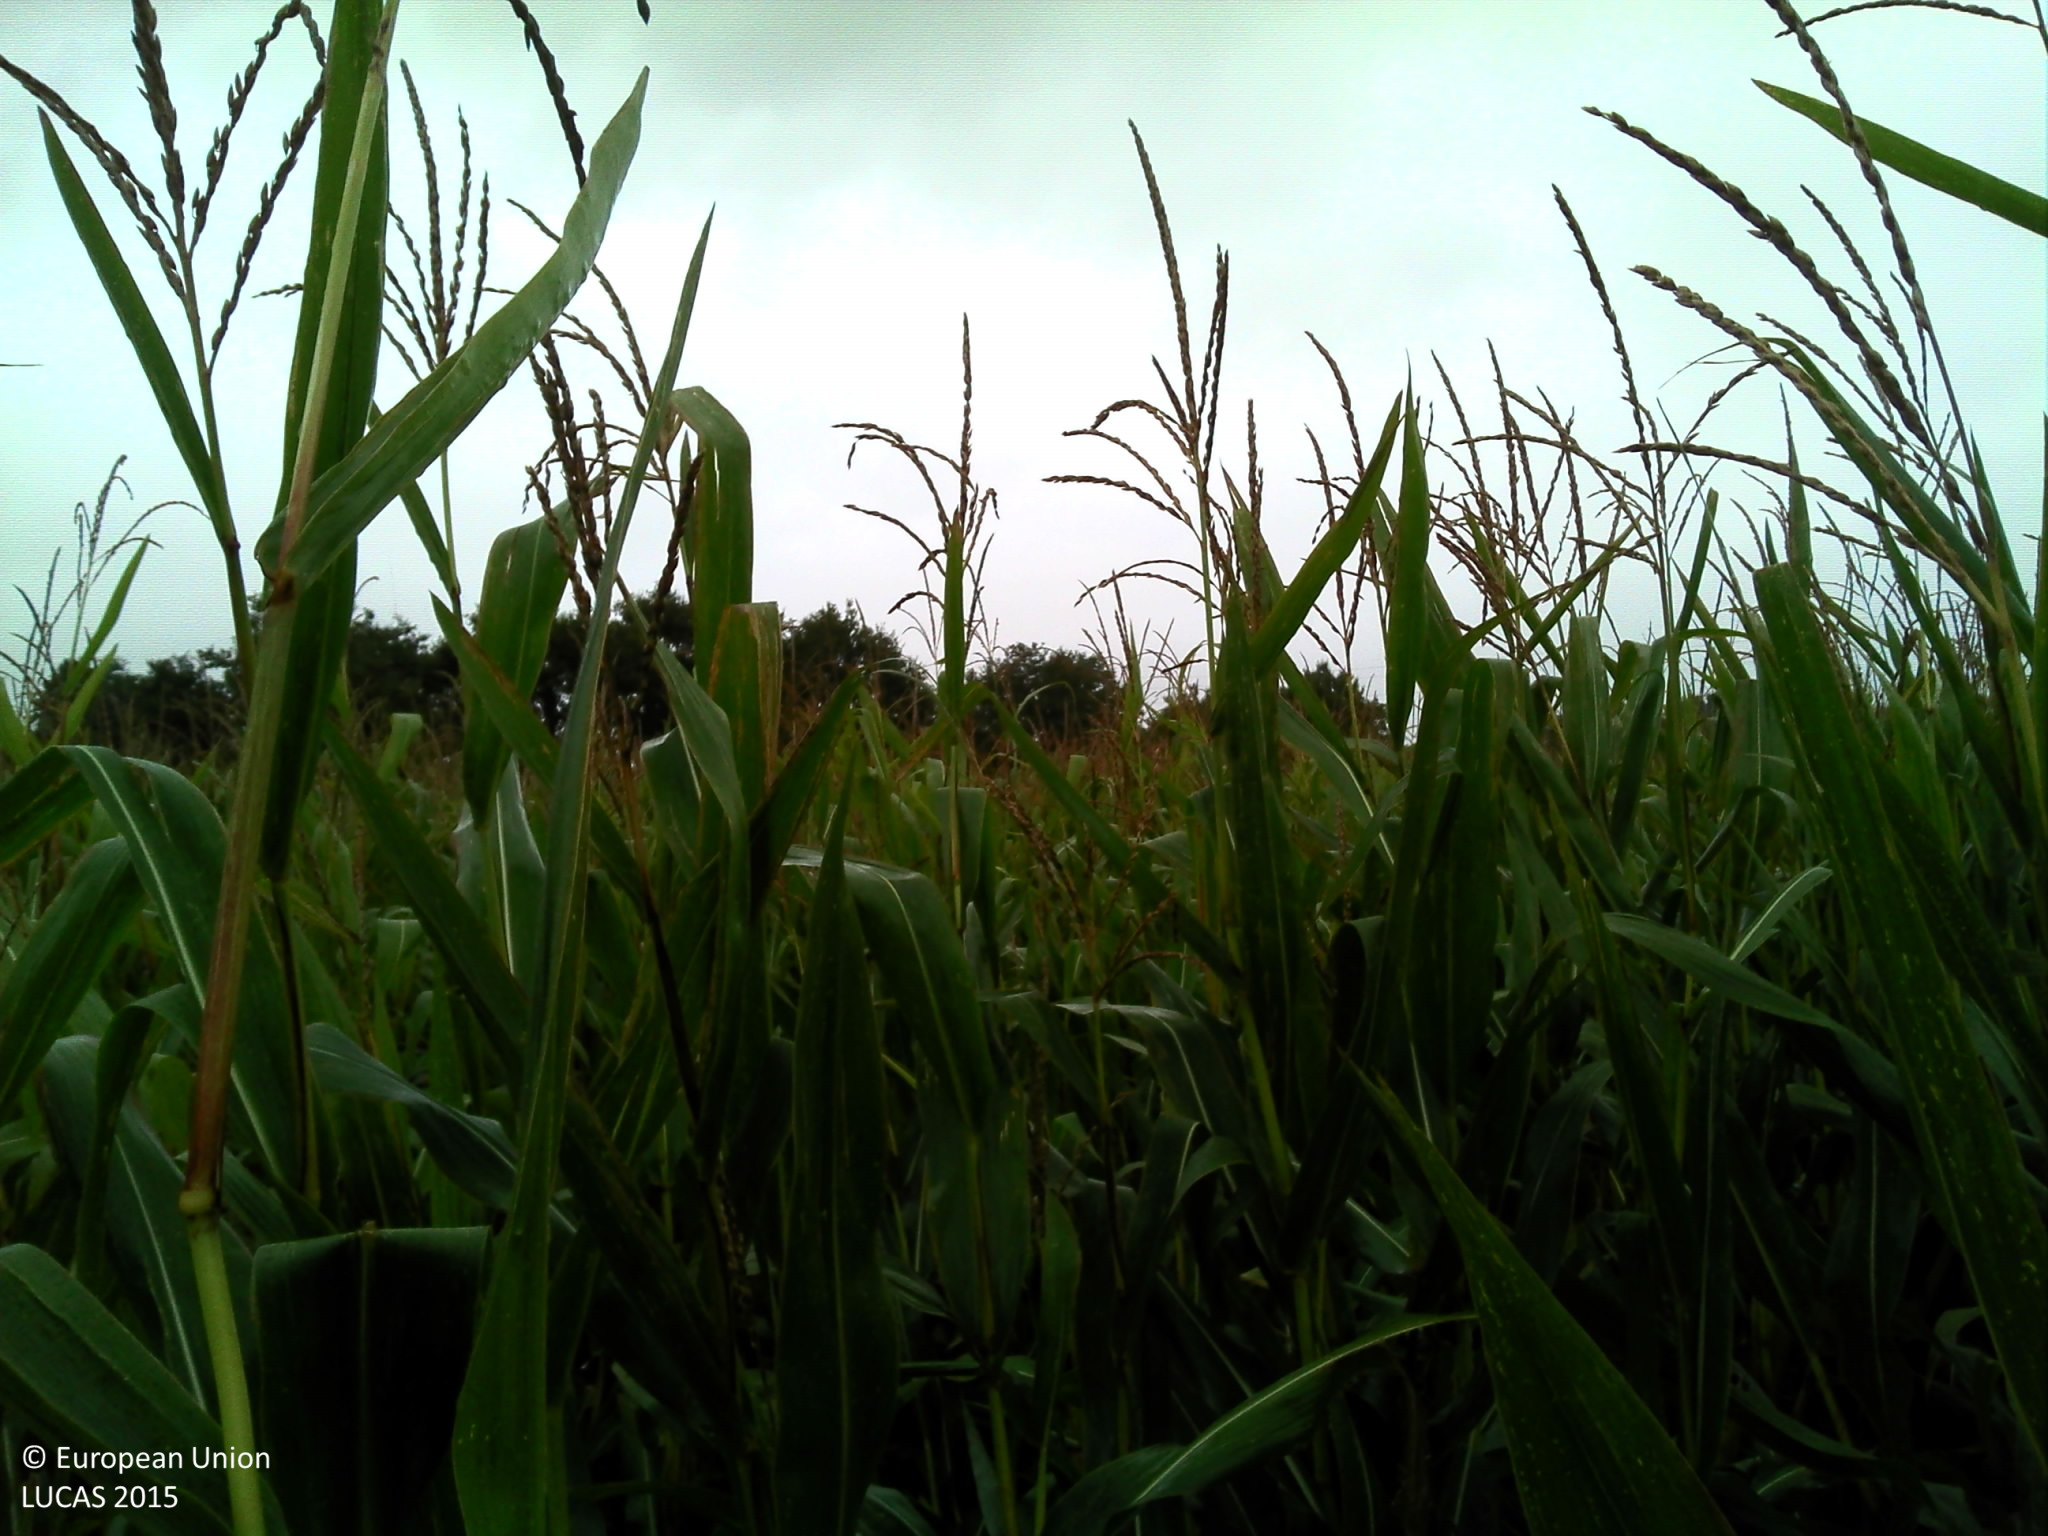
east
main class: Cropland
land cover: Maize
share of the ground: > 75 %
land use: Agriculture (excluding fallow land and kitchen gardens)
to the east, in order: Maize; Grass margins; Broadleaved woodland; Fences; Broadleaved woodland; Ditches and canals; Electric lines; Grass margins; Paved roads, cycling and walking lanes; Grass margins; Ditches and canals; Broadleaved woodland; Fences; Grassland without tree/shrub cover; Broadleaved woodland; Grassland without tree/shrub cover
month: September
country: FR
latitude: 46.6317
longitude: -1.3878
